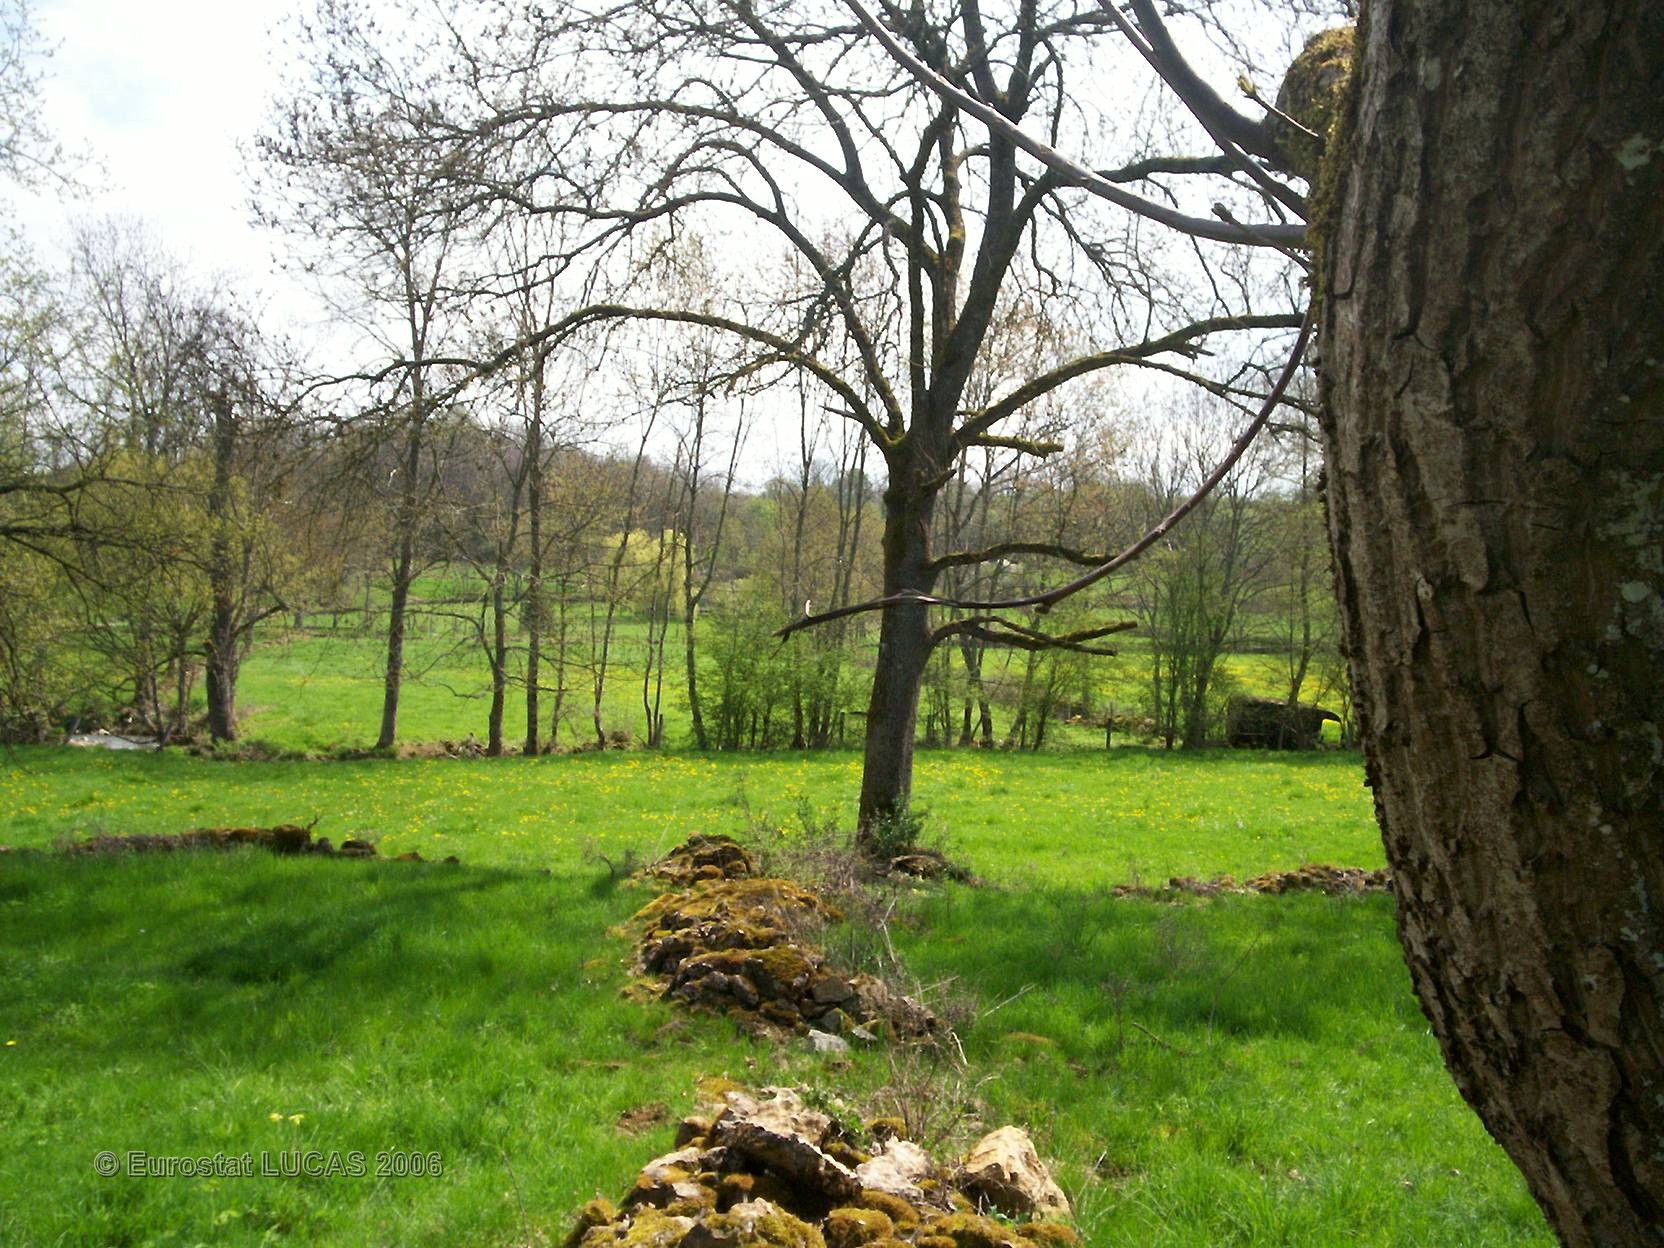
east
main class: Grassland
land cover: Grassland with sparse tree/shrub cover
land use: Agriculture (excluding fallow land and kitchen gardens)
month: April
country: FR
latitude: 46.9381
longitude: 4.6279
